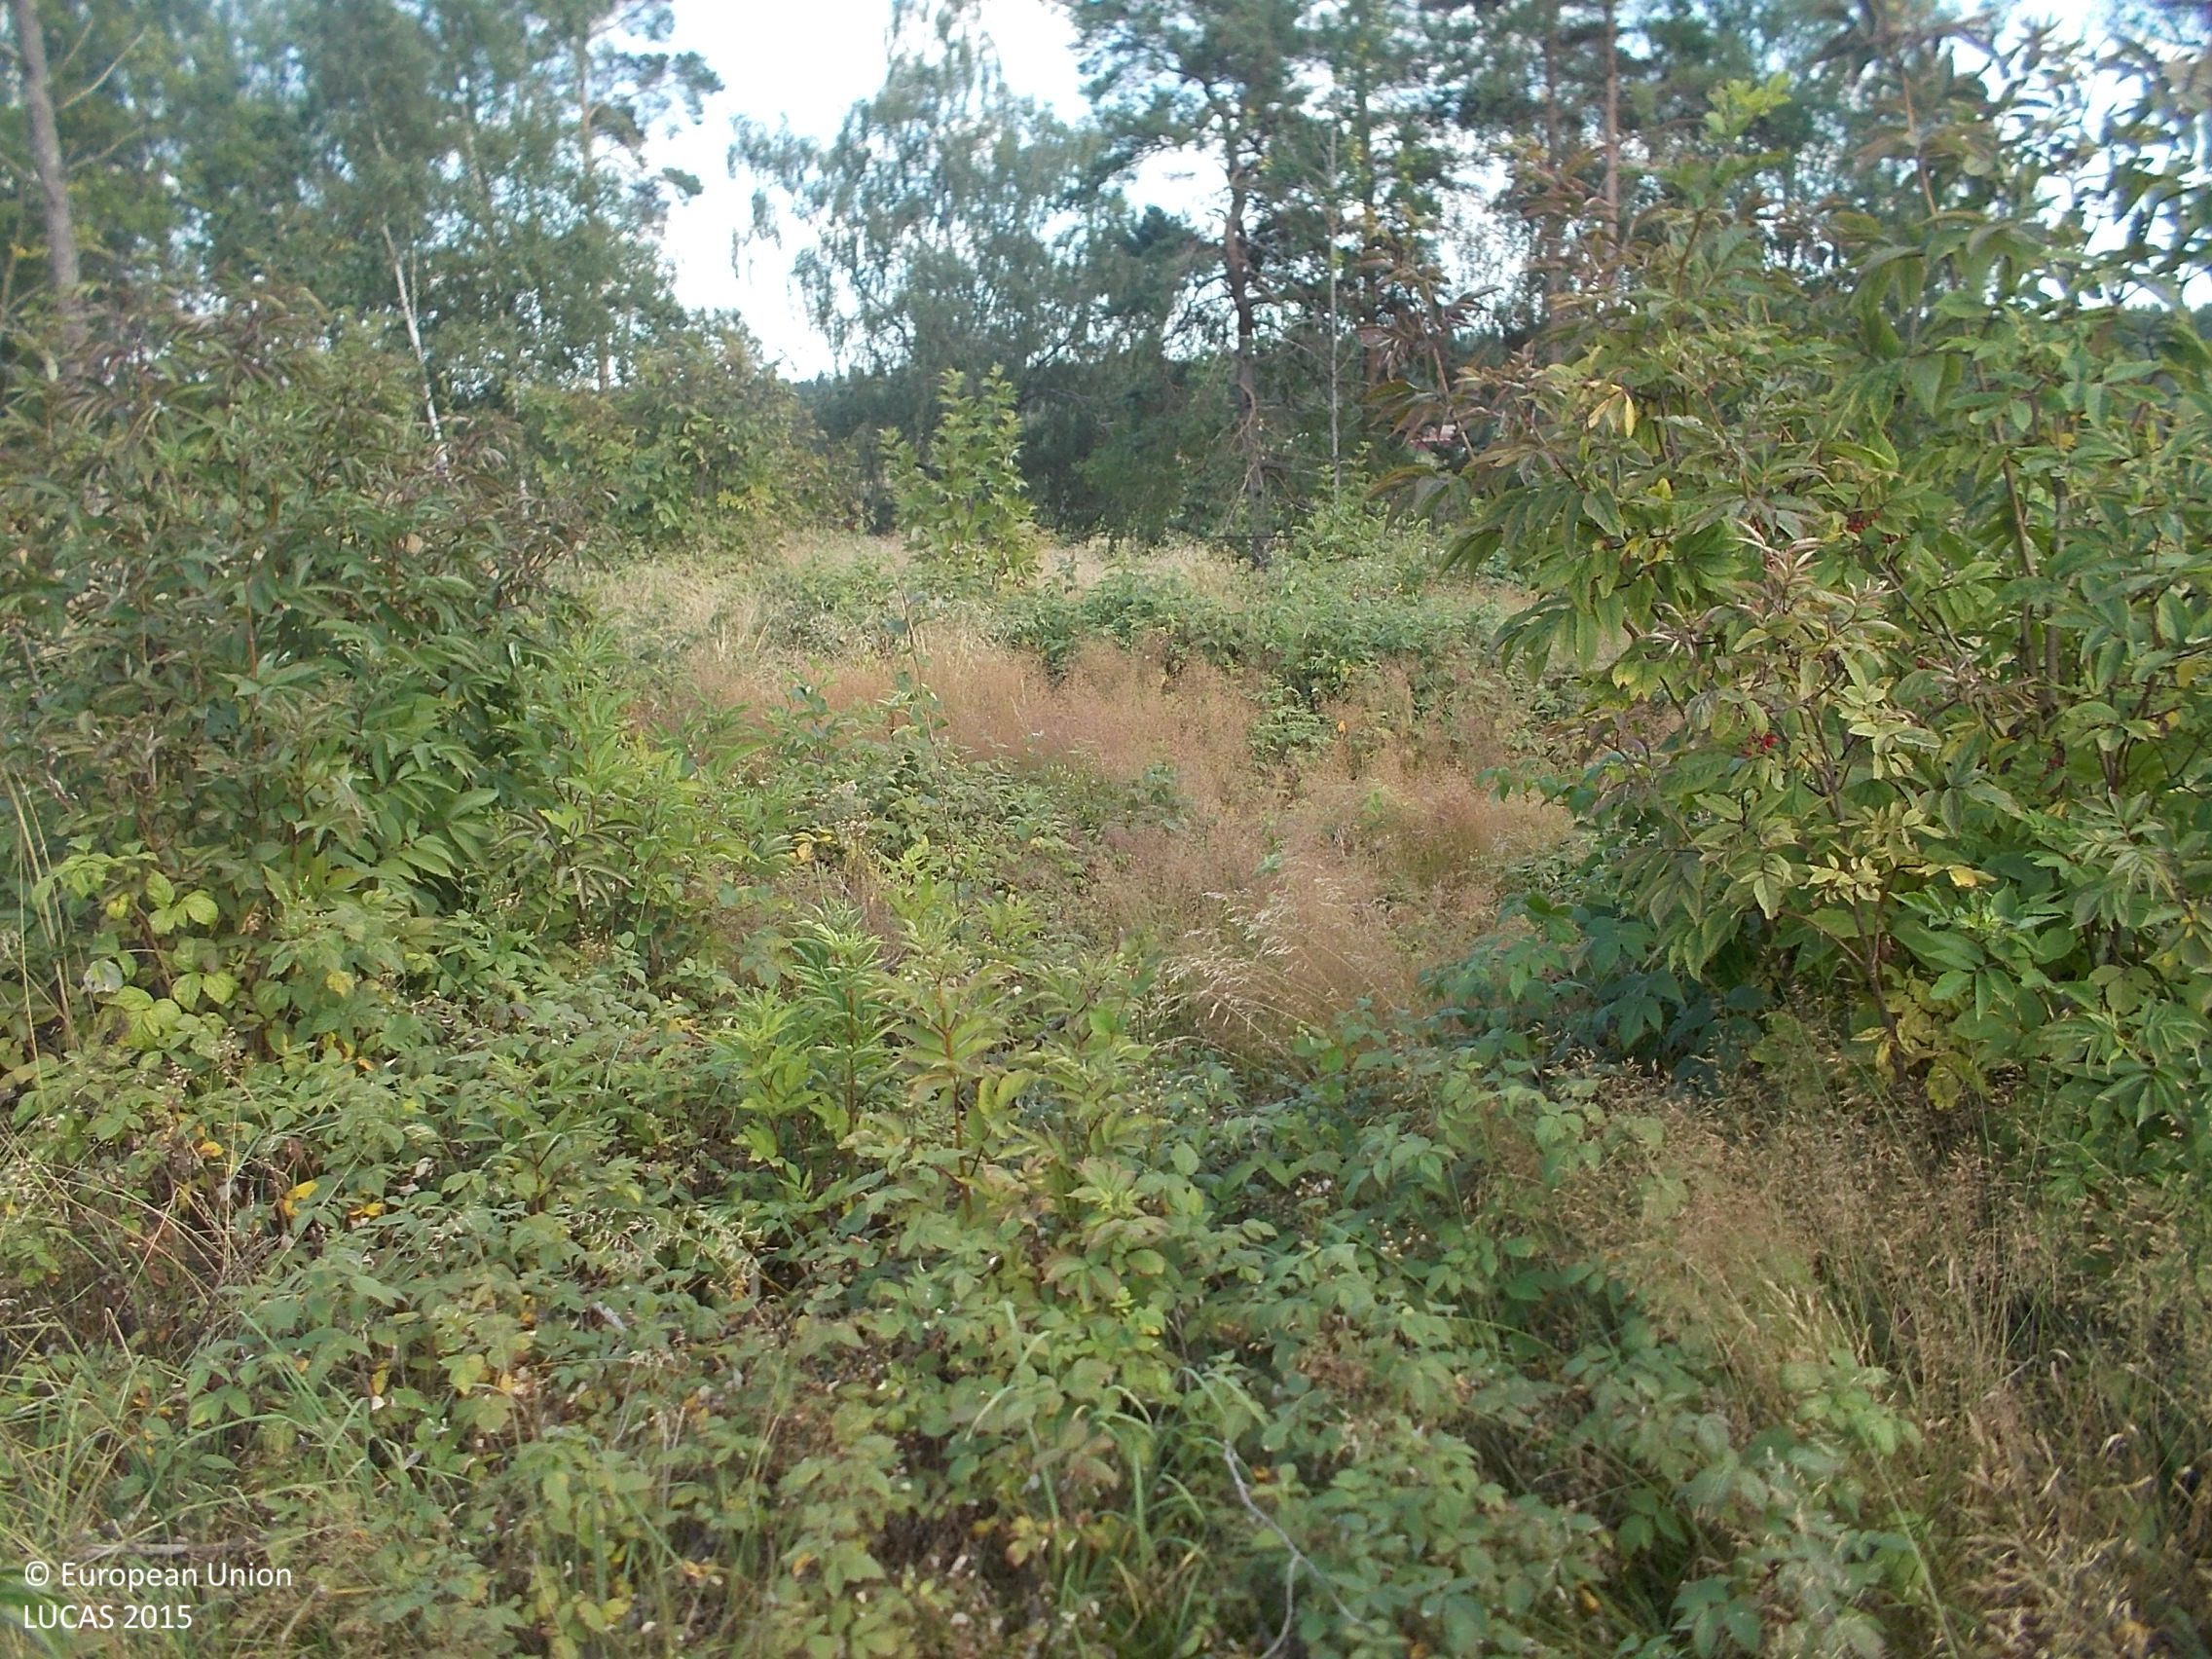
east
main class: Shrubland
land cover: Shrubland with sparse tree cover
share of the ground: > 75 %
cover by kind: shrubs 80 %, herbaceous plants 15 %, broadleaved forest trees 5 %
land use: Forestry
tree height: > 5 m
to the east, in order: Shrubland with sparse tree cover; Electric lines; Pine dominated mixed woodland; Grass margins; Paved roads, cycling and walking lanes; Grass margins; Fences; Grassland with sparse tree/shrub cover; Barley; Spontaneously vegetated surfaces; Rivers and streams; Spontaneously vegetated surfaces; Electric lines; Fences; Temporary grasslands
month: August
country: SE
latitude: 57.5510
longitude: 13.2207
